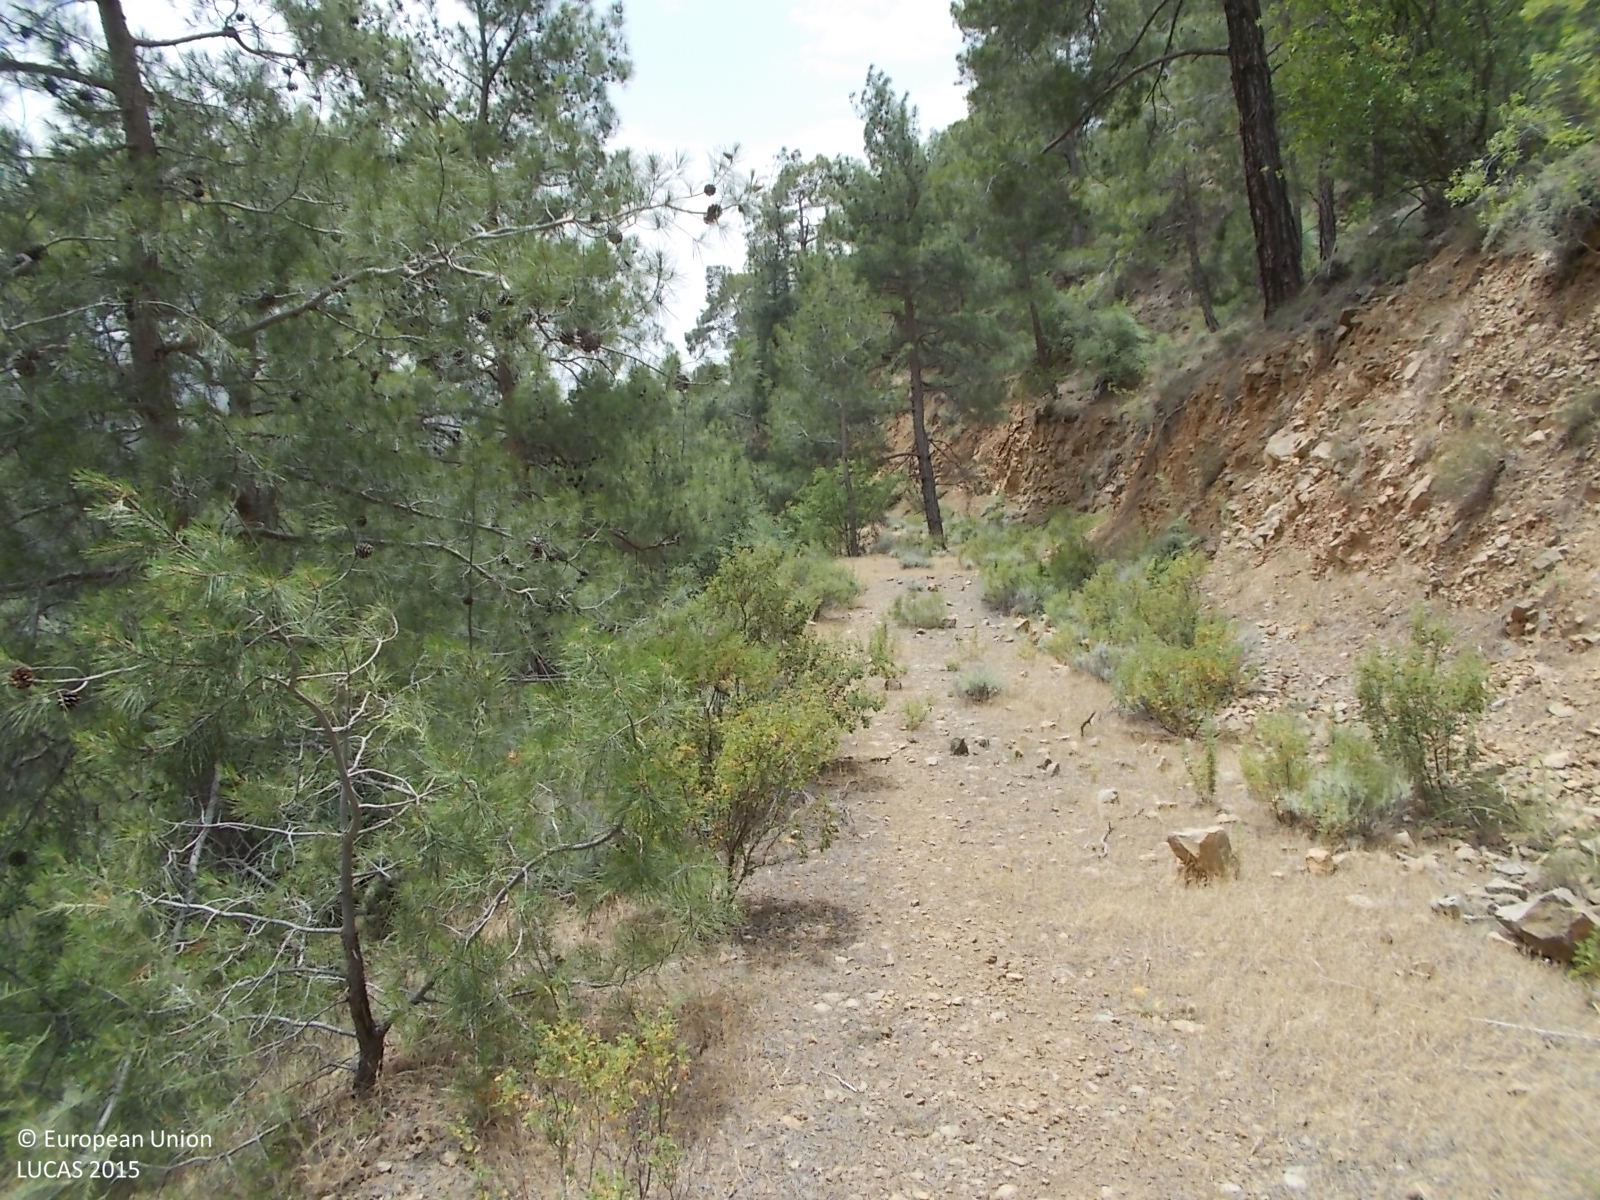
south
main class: Woodland
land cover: Pine dominated coniferous woodland
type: coniferous forest of the mediterranean region
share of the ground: > 75 %
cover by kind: coniferous forest trees 90 %, shrubs 10 %
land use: Semi-natural and natural areas not in use
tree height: > 5 m
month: May
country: CY
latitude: 34.9529
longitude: 32.5944
